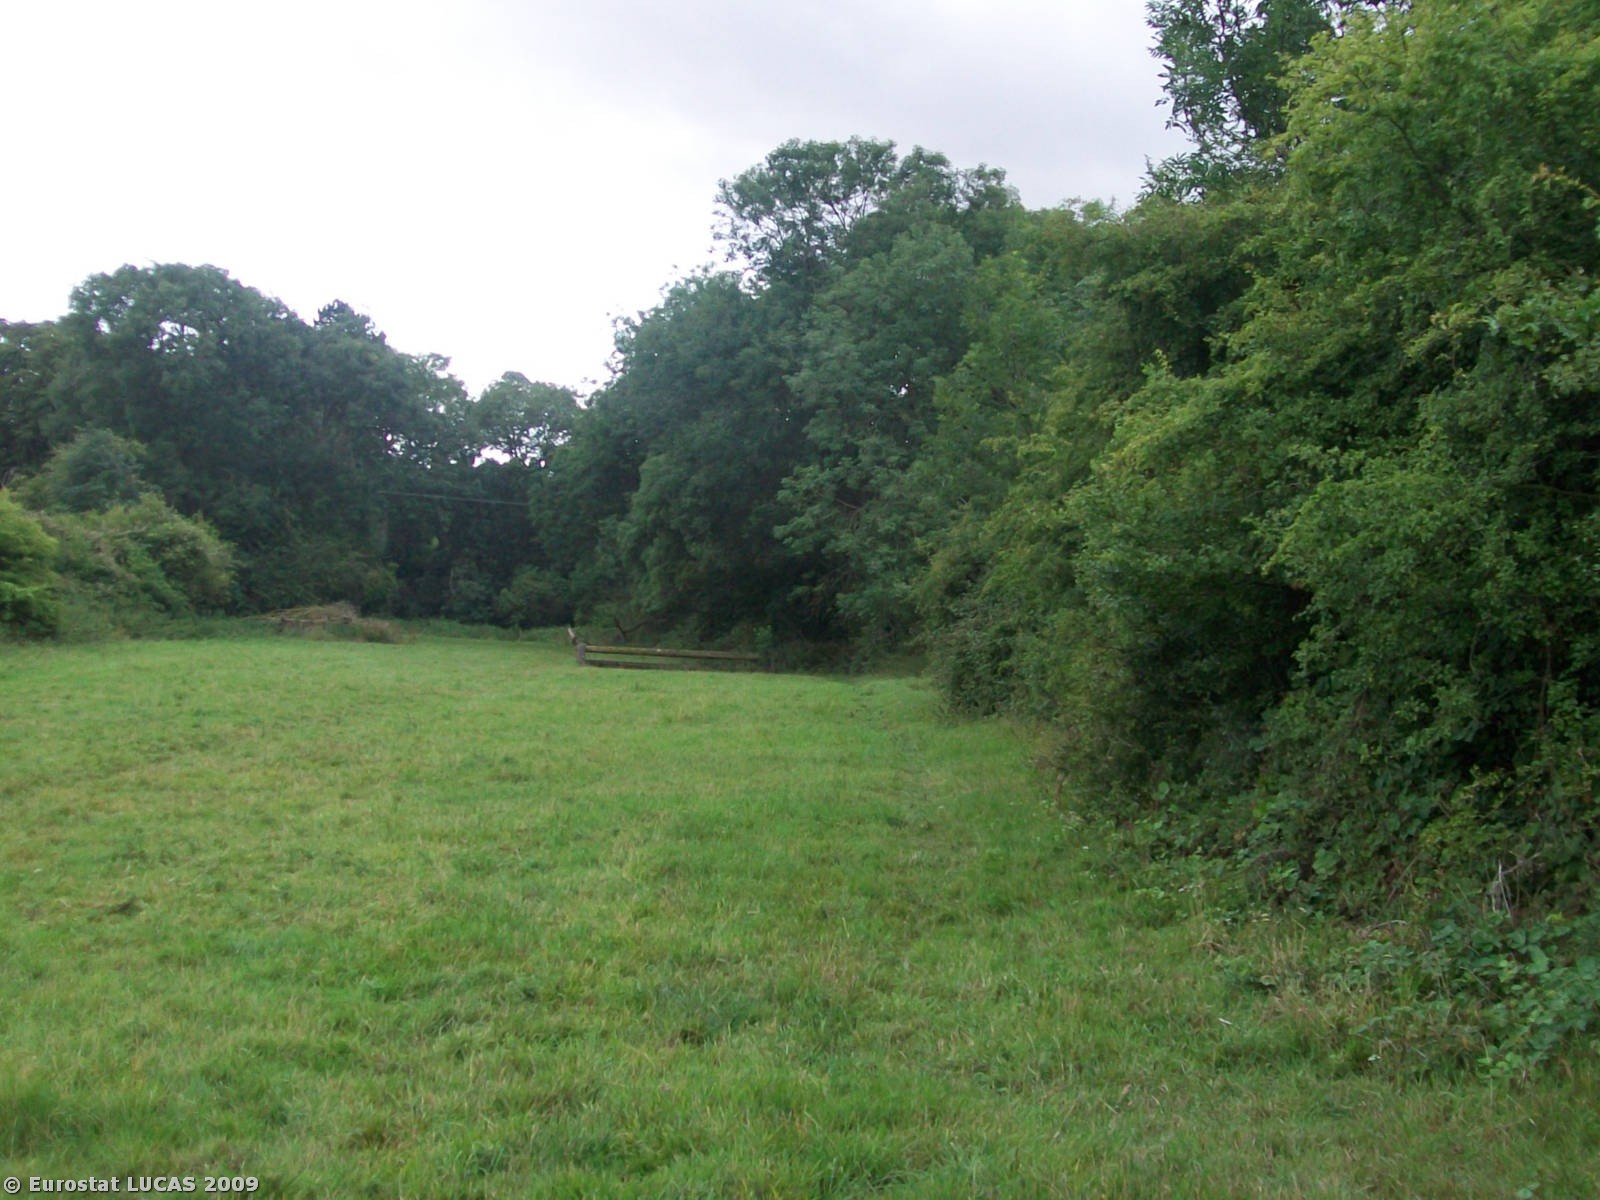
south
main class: Grassland
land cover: Grassland without tree/shrub cover
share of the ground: > 75 %
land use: Agriculture (excluding fallow land and kitchen gardens)
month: July
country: GB
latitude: 51.9615
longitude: 0.0864
